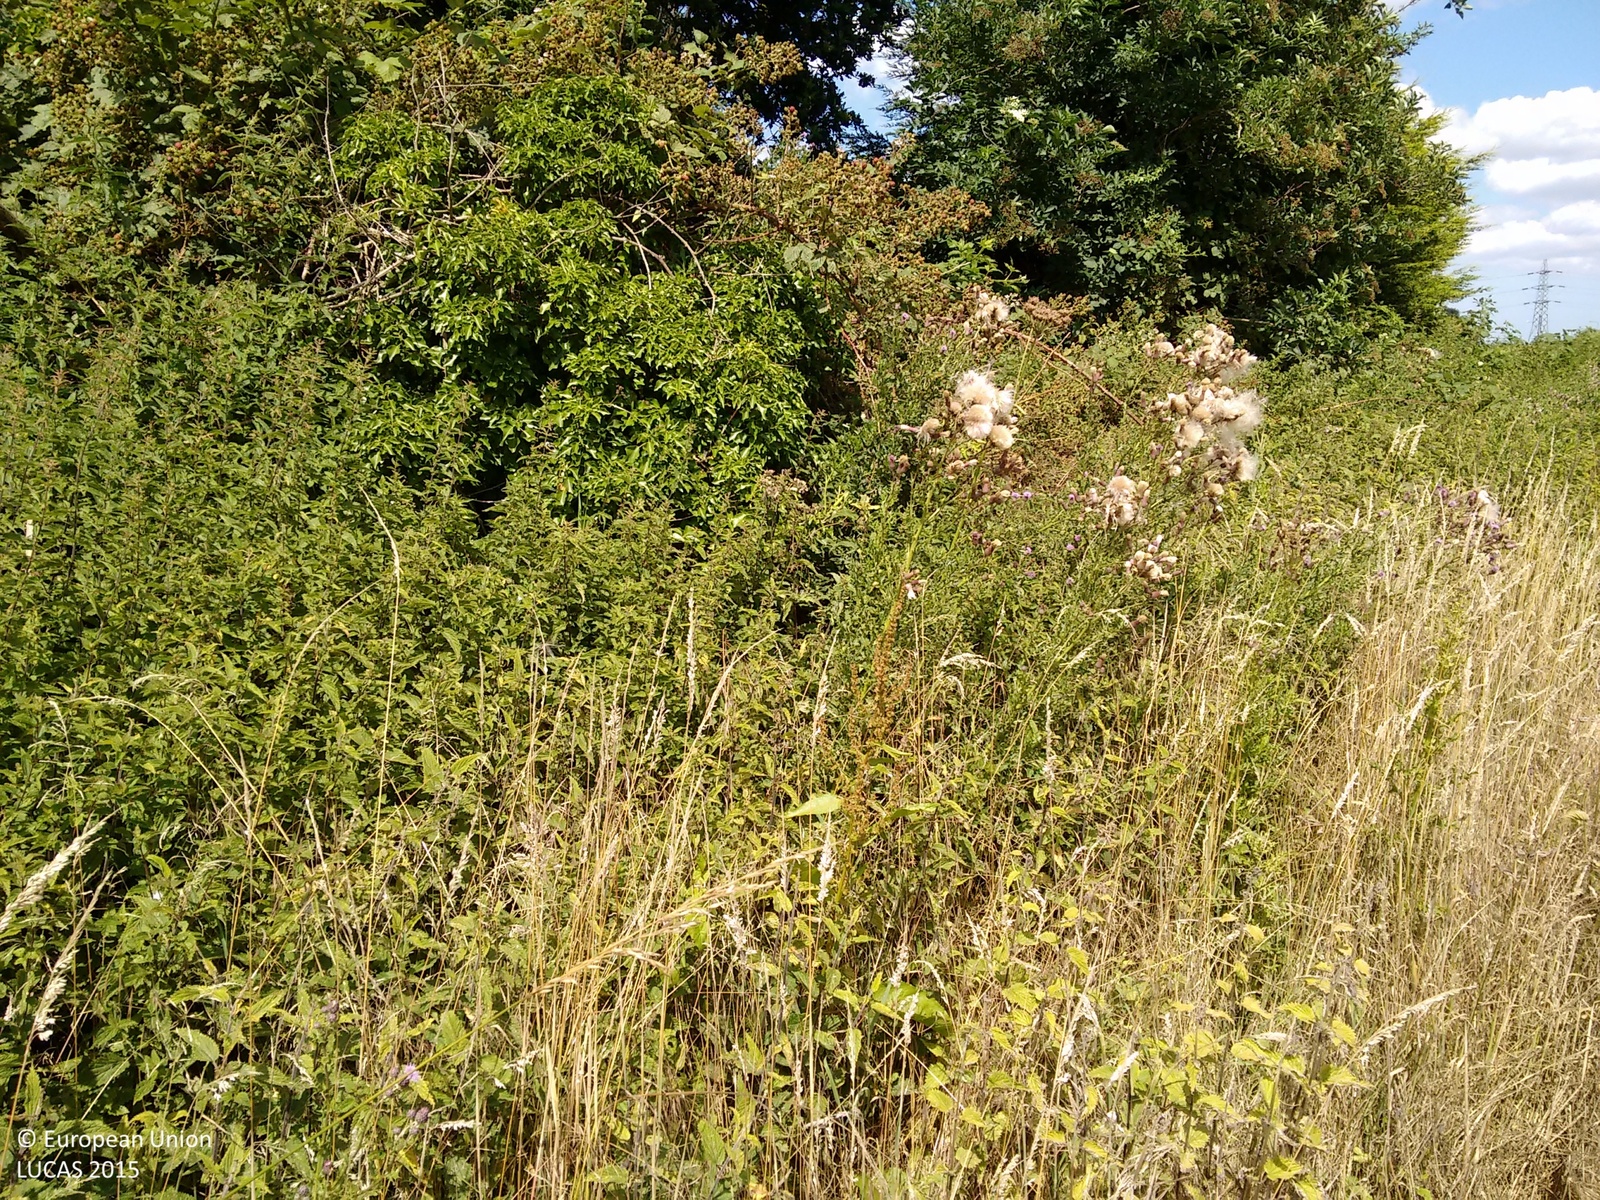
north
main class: Cropland
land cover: Barley
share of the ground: > 75 %
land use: Agriculture (excluding fallow land and kitchen gardens)
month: July
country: GB
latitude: 52.7316
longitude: 0.4201
